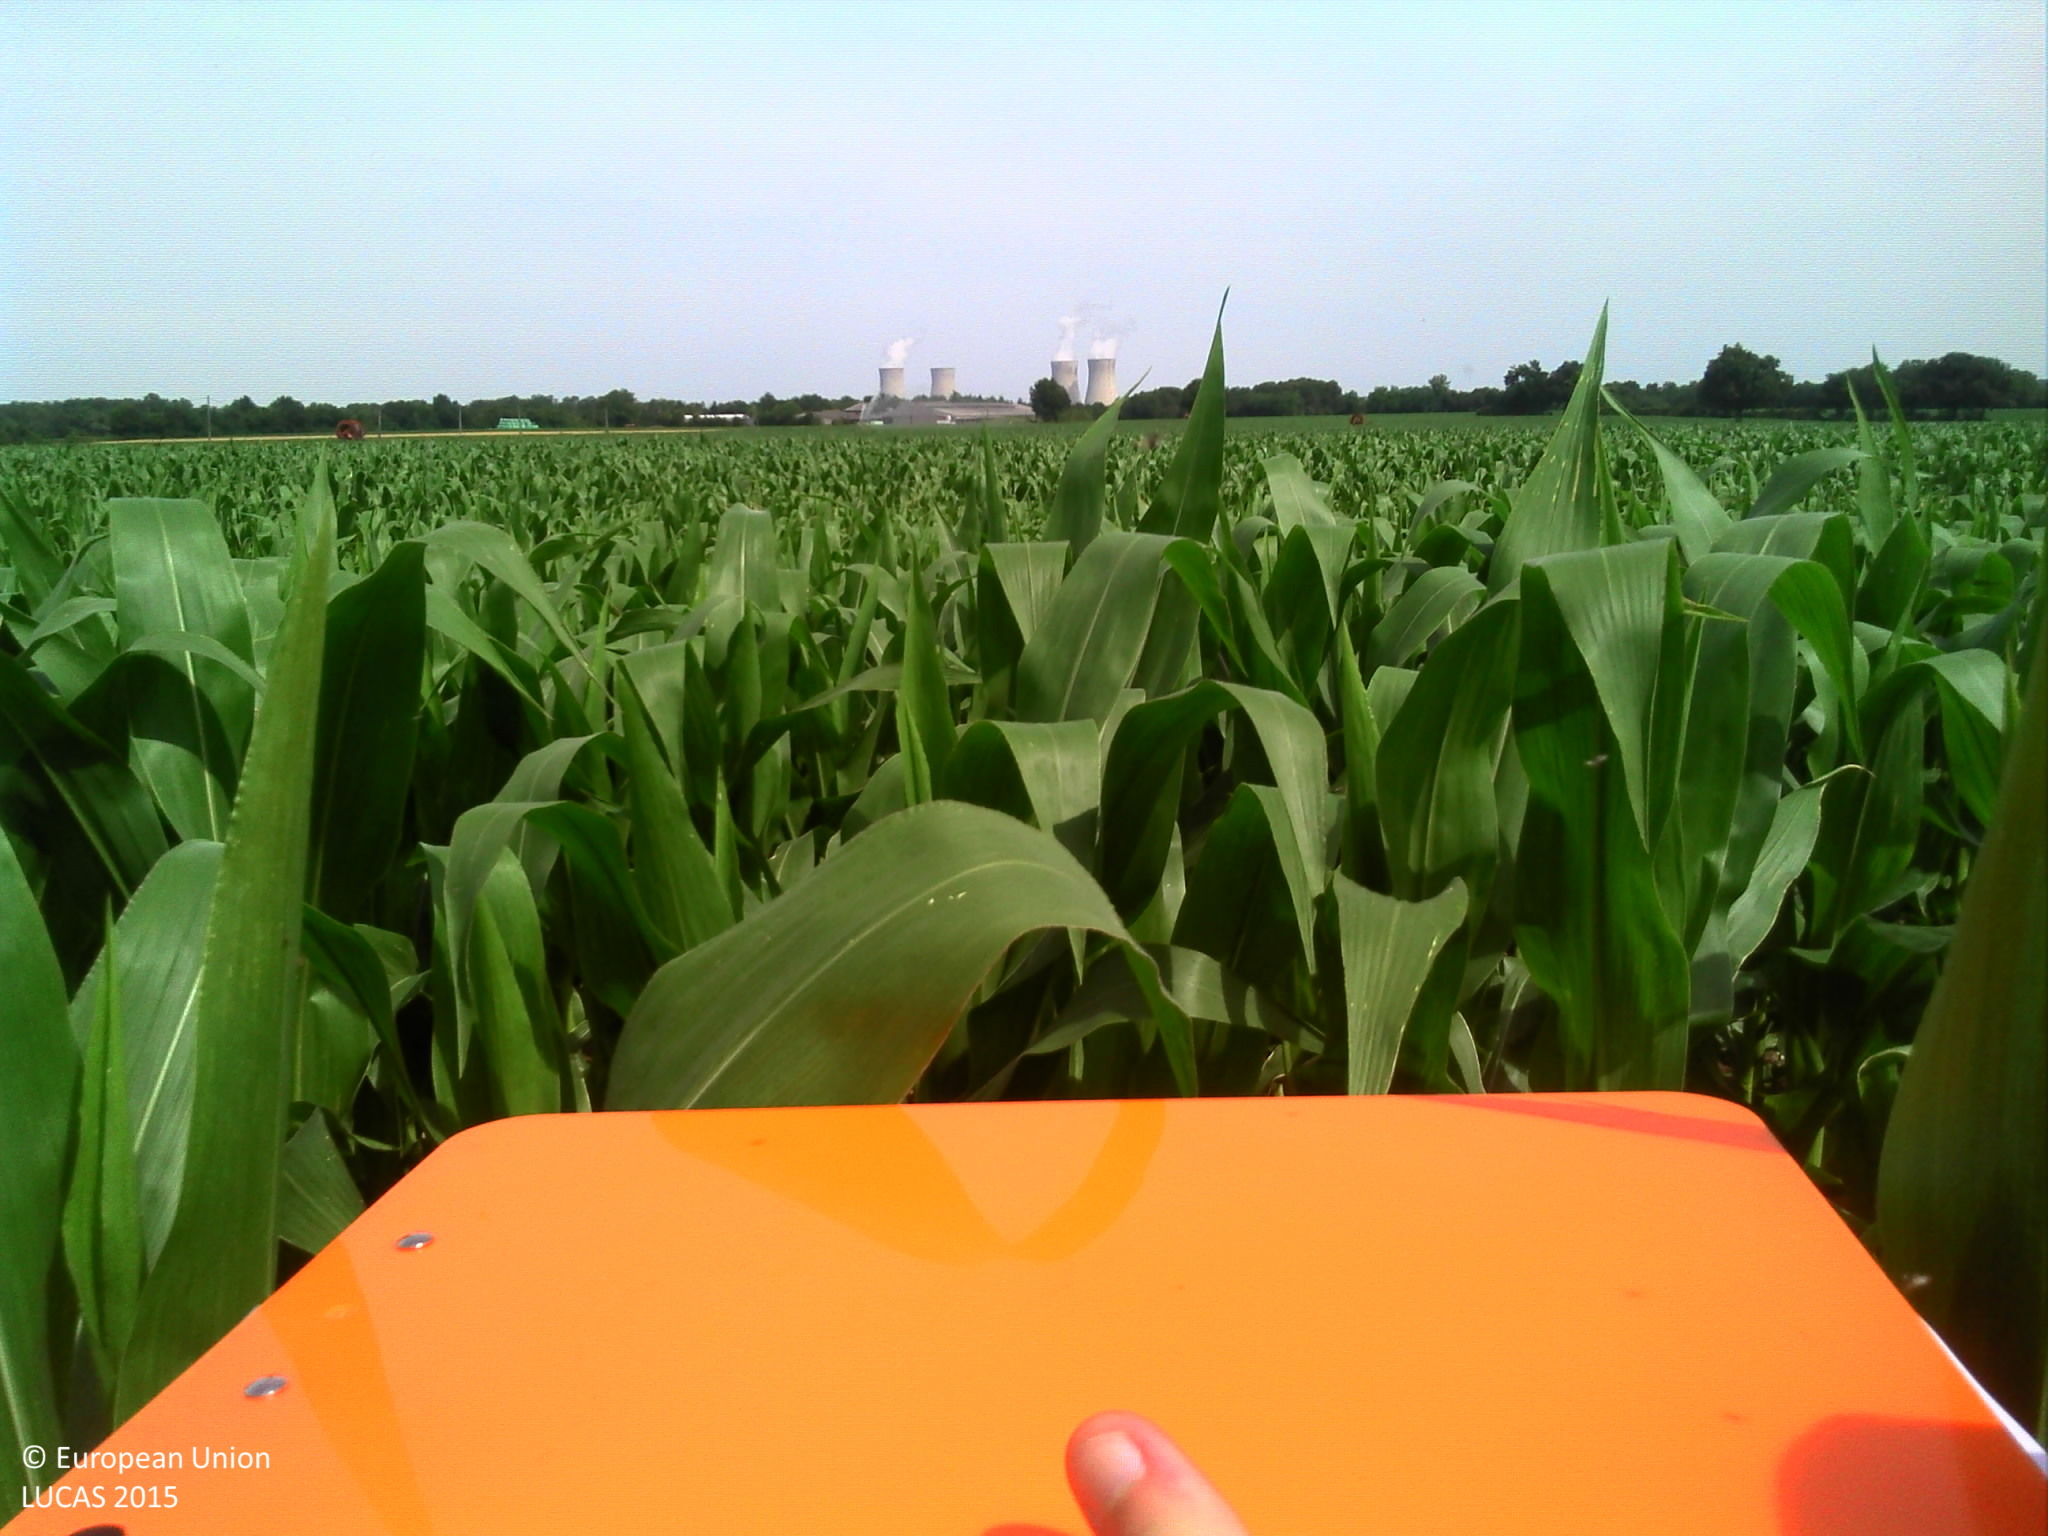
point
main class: Cropland
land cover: Maize
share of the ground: > 75 %
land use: Agriculture (excluding fallow land and kitchen gardens)
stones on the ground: 25 - 50 %
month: June
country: FR
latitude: 47.6818
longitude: 2.5451
